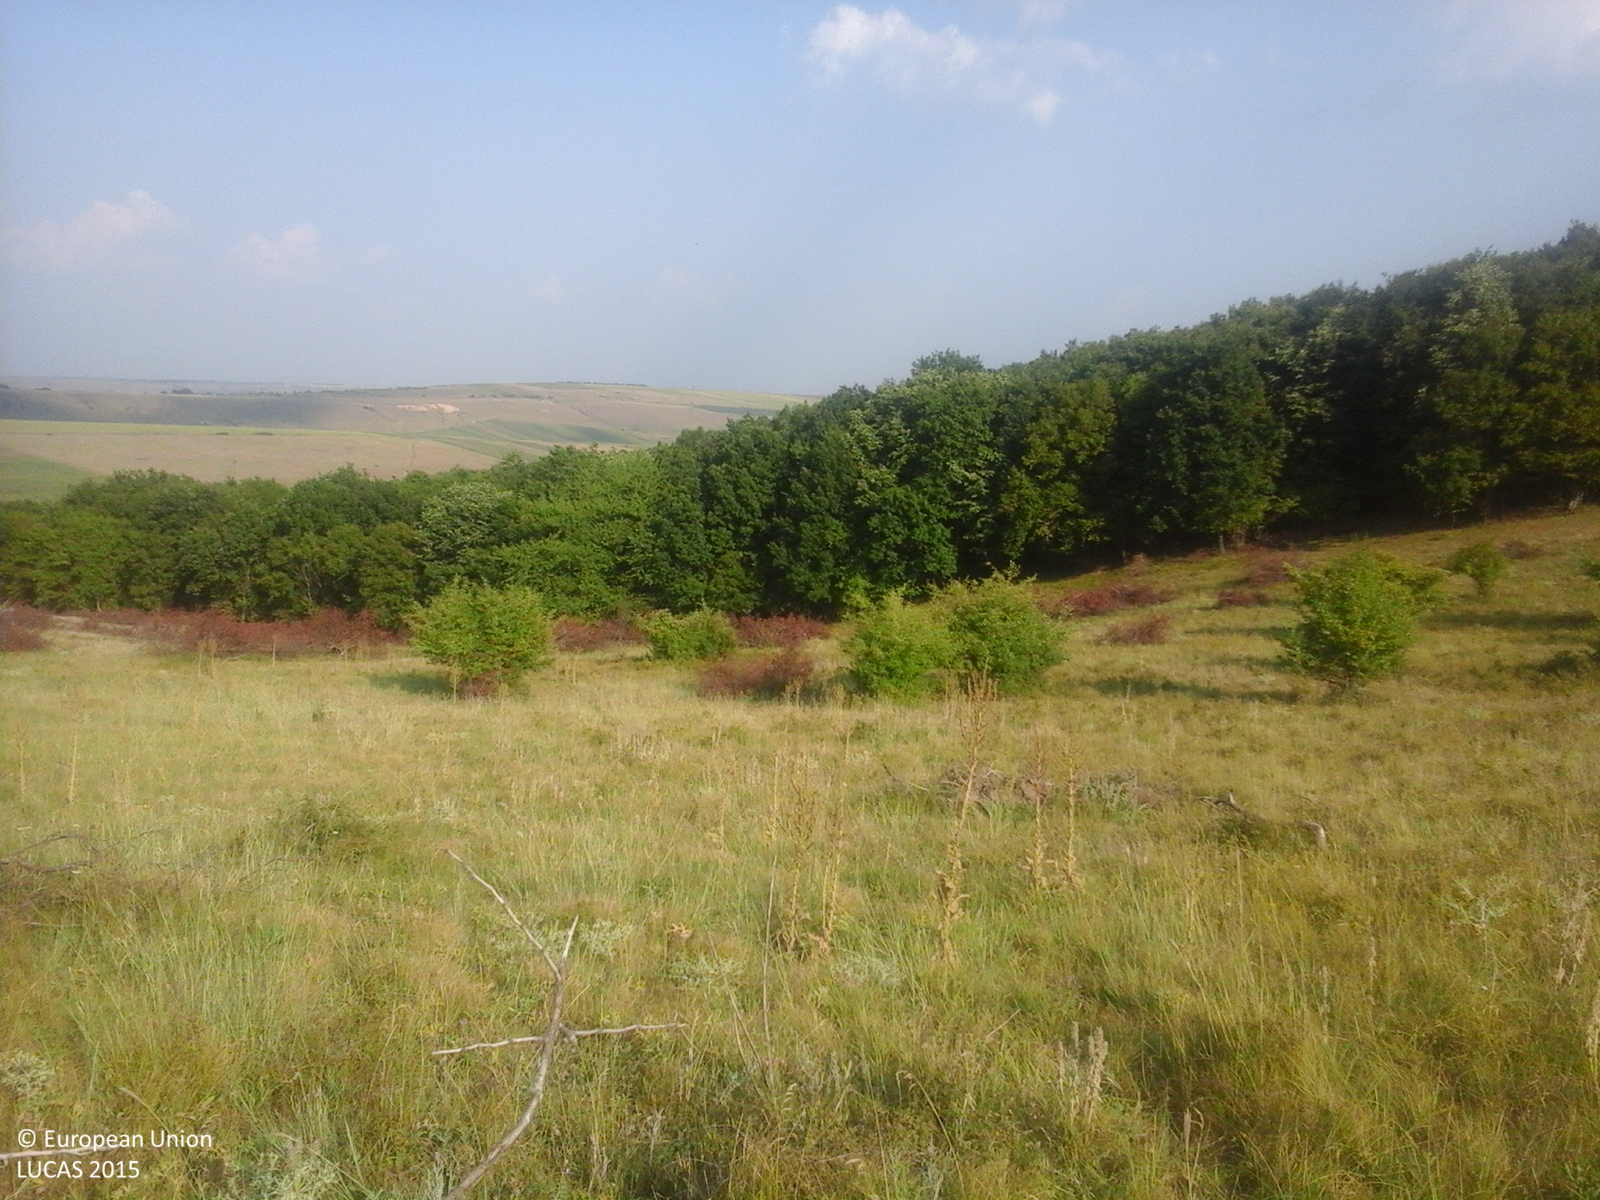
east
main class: Grassland
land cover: Grassland with sparse tree/shrub cover
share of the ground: > 75 %
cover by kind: herbaceous plants 85 %, shrubs 10 %, broadleaved forest trees 5 %
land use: Fallow land
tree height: > 5 m
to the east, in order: Grassland with sparse tree/shrub cover; Broadleaved woodland
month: July
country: RO
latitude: 46.5923
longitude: 28.0227
